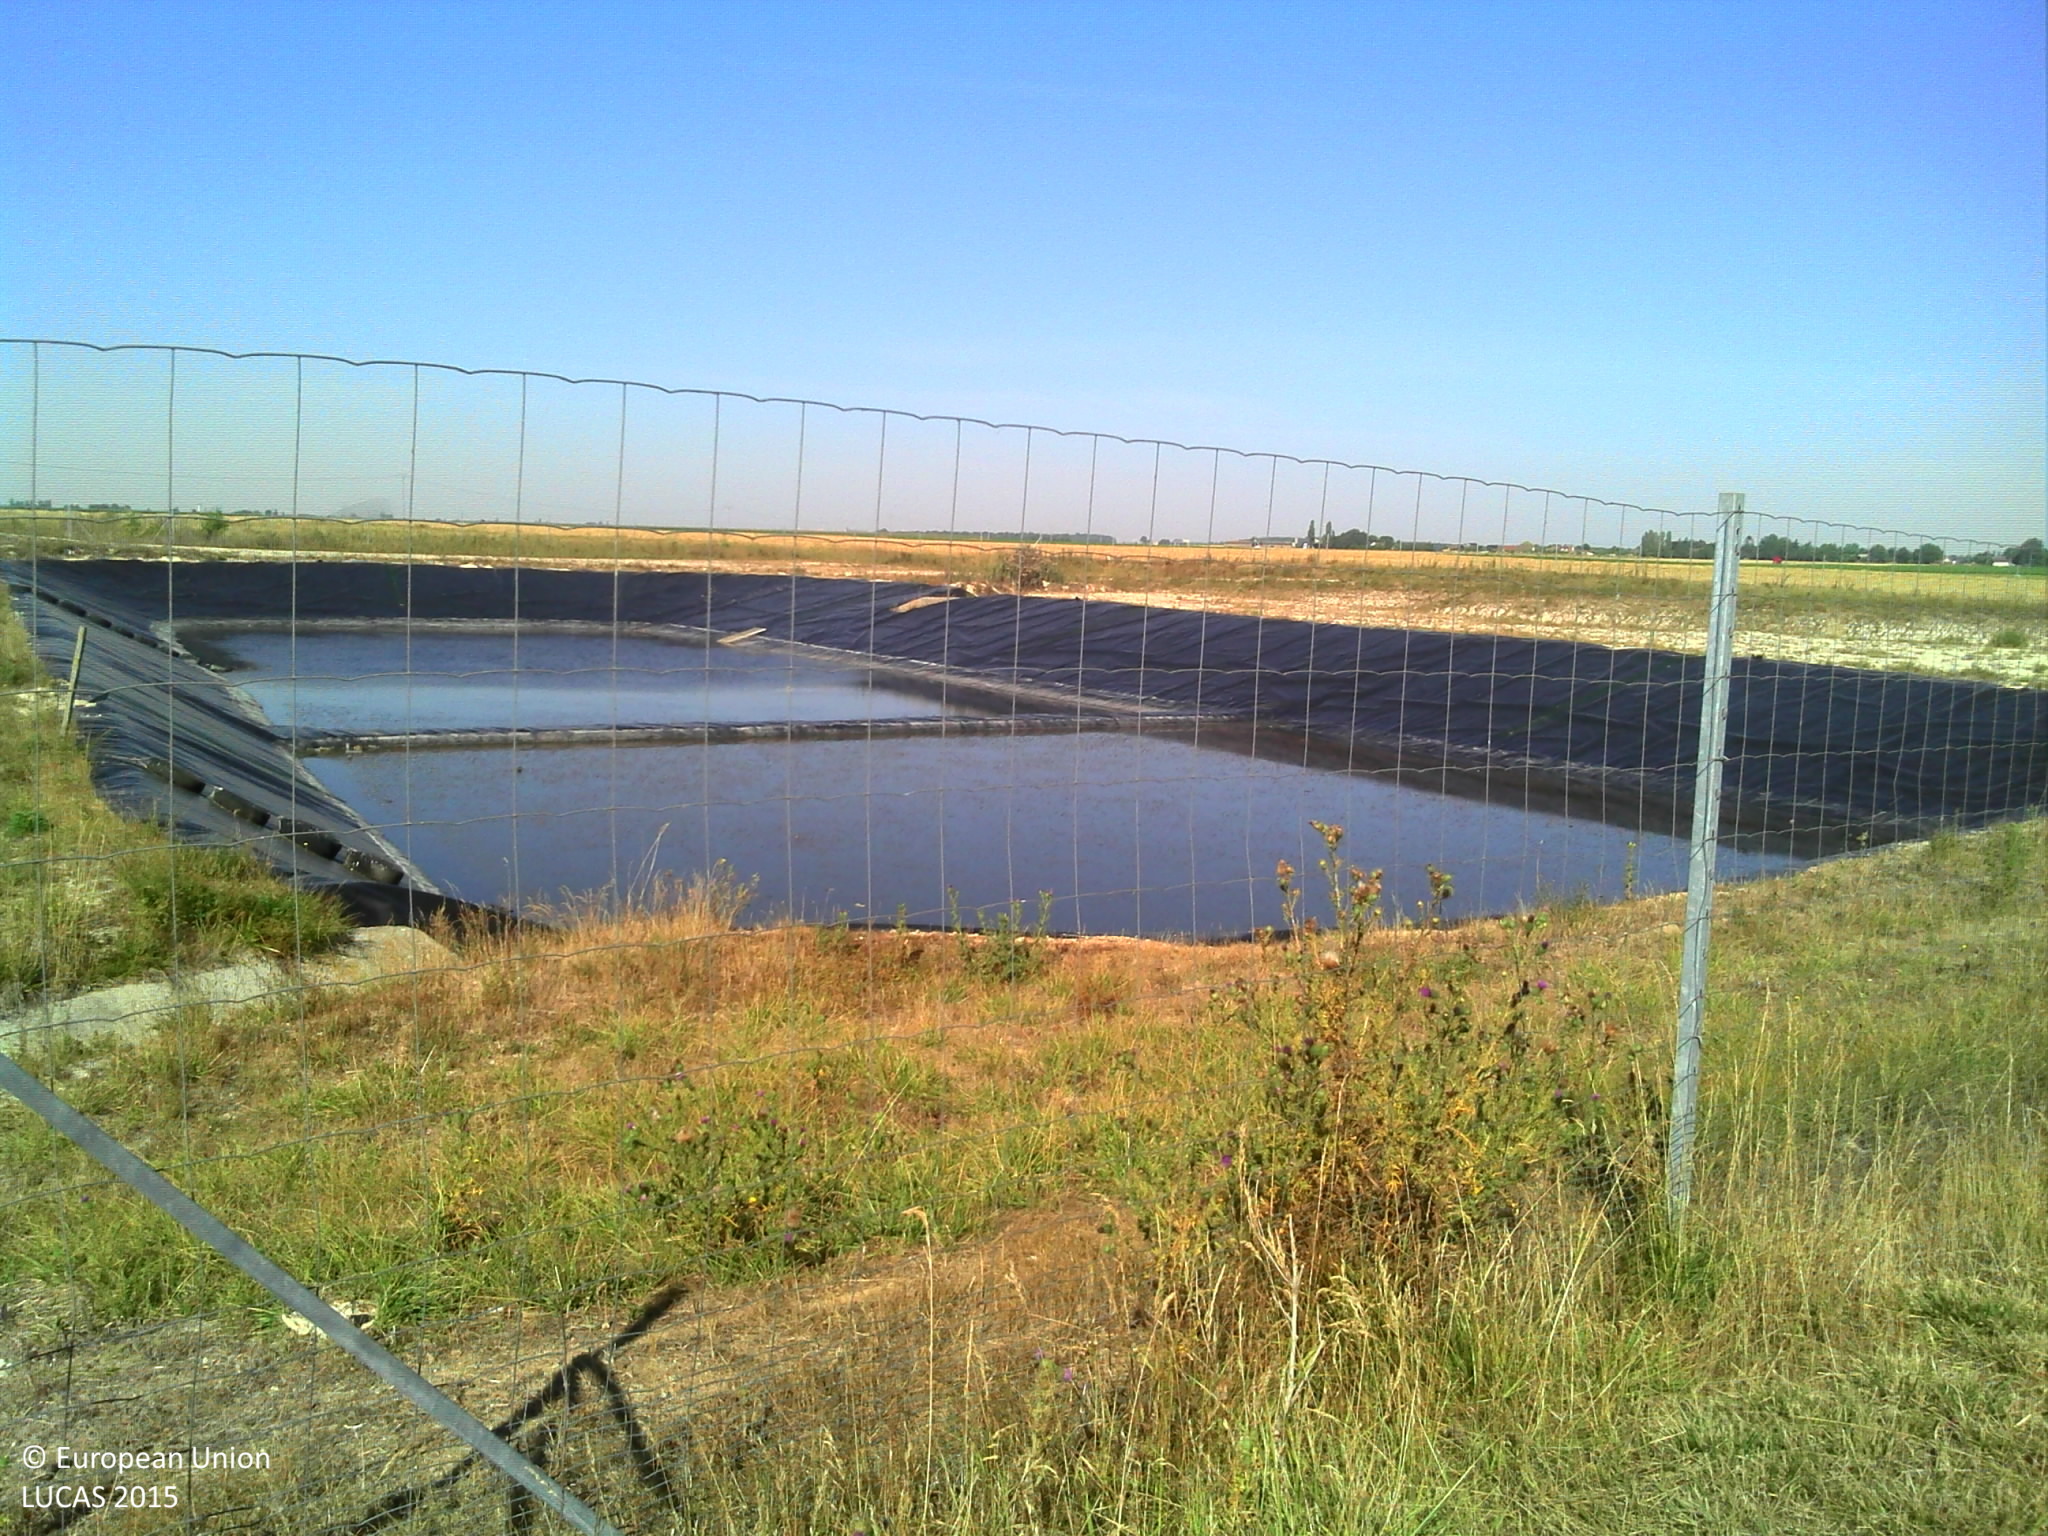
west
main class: Grassland
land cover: Grassland without tree/shrub cover
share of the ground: > 75 %
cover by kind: herbaceous plants 100 %
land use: Road transport
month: August
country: FR
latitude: 48.0971
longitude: 2.0250
